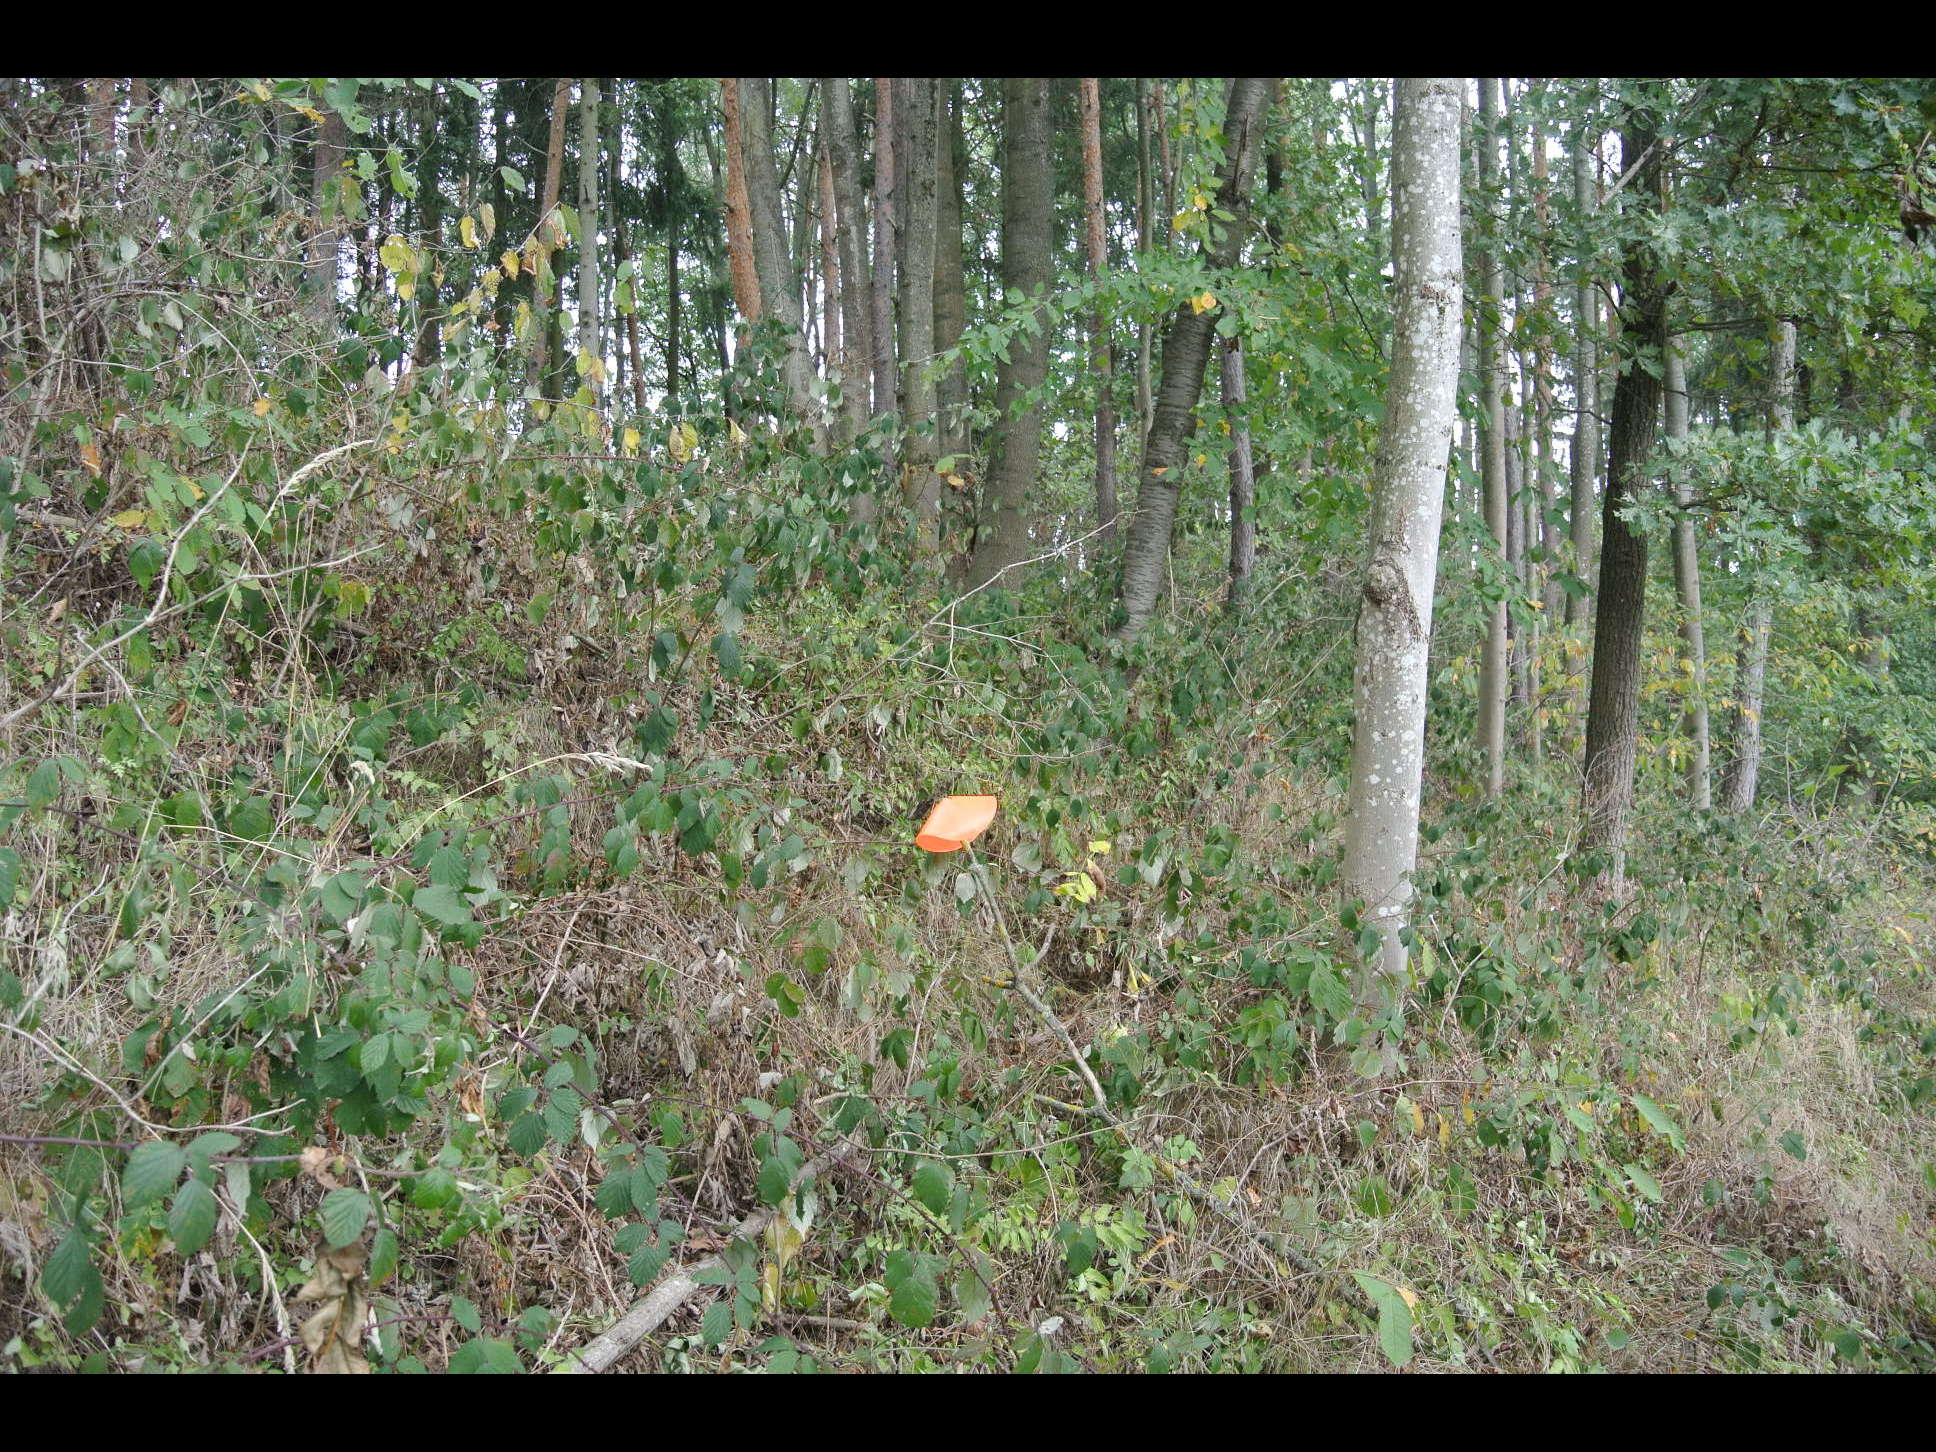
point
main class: Woodland
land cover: Pine dominated mixed woodland
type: alpine coniferous forest
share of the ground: > 75 %
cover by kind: broadleaved forest trees 65 %, coniferous forest trees 35 %
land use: Forestry
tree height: > 5 m
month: July
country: AT
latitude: 47.5325
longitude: 16.3928
